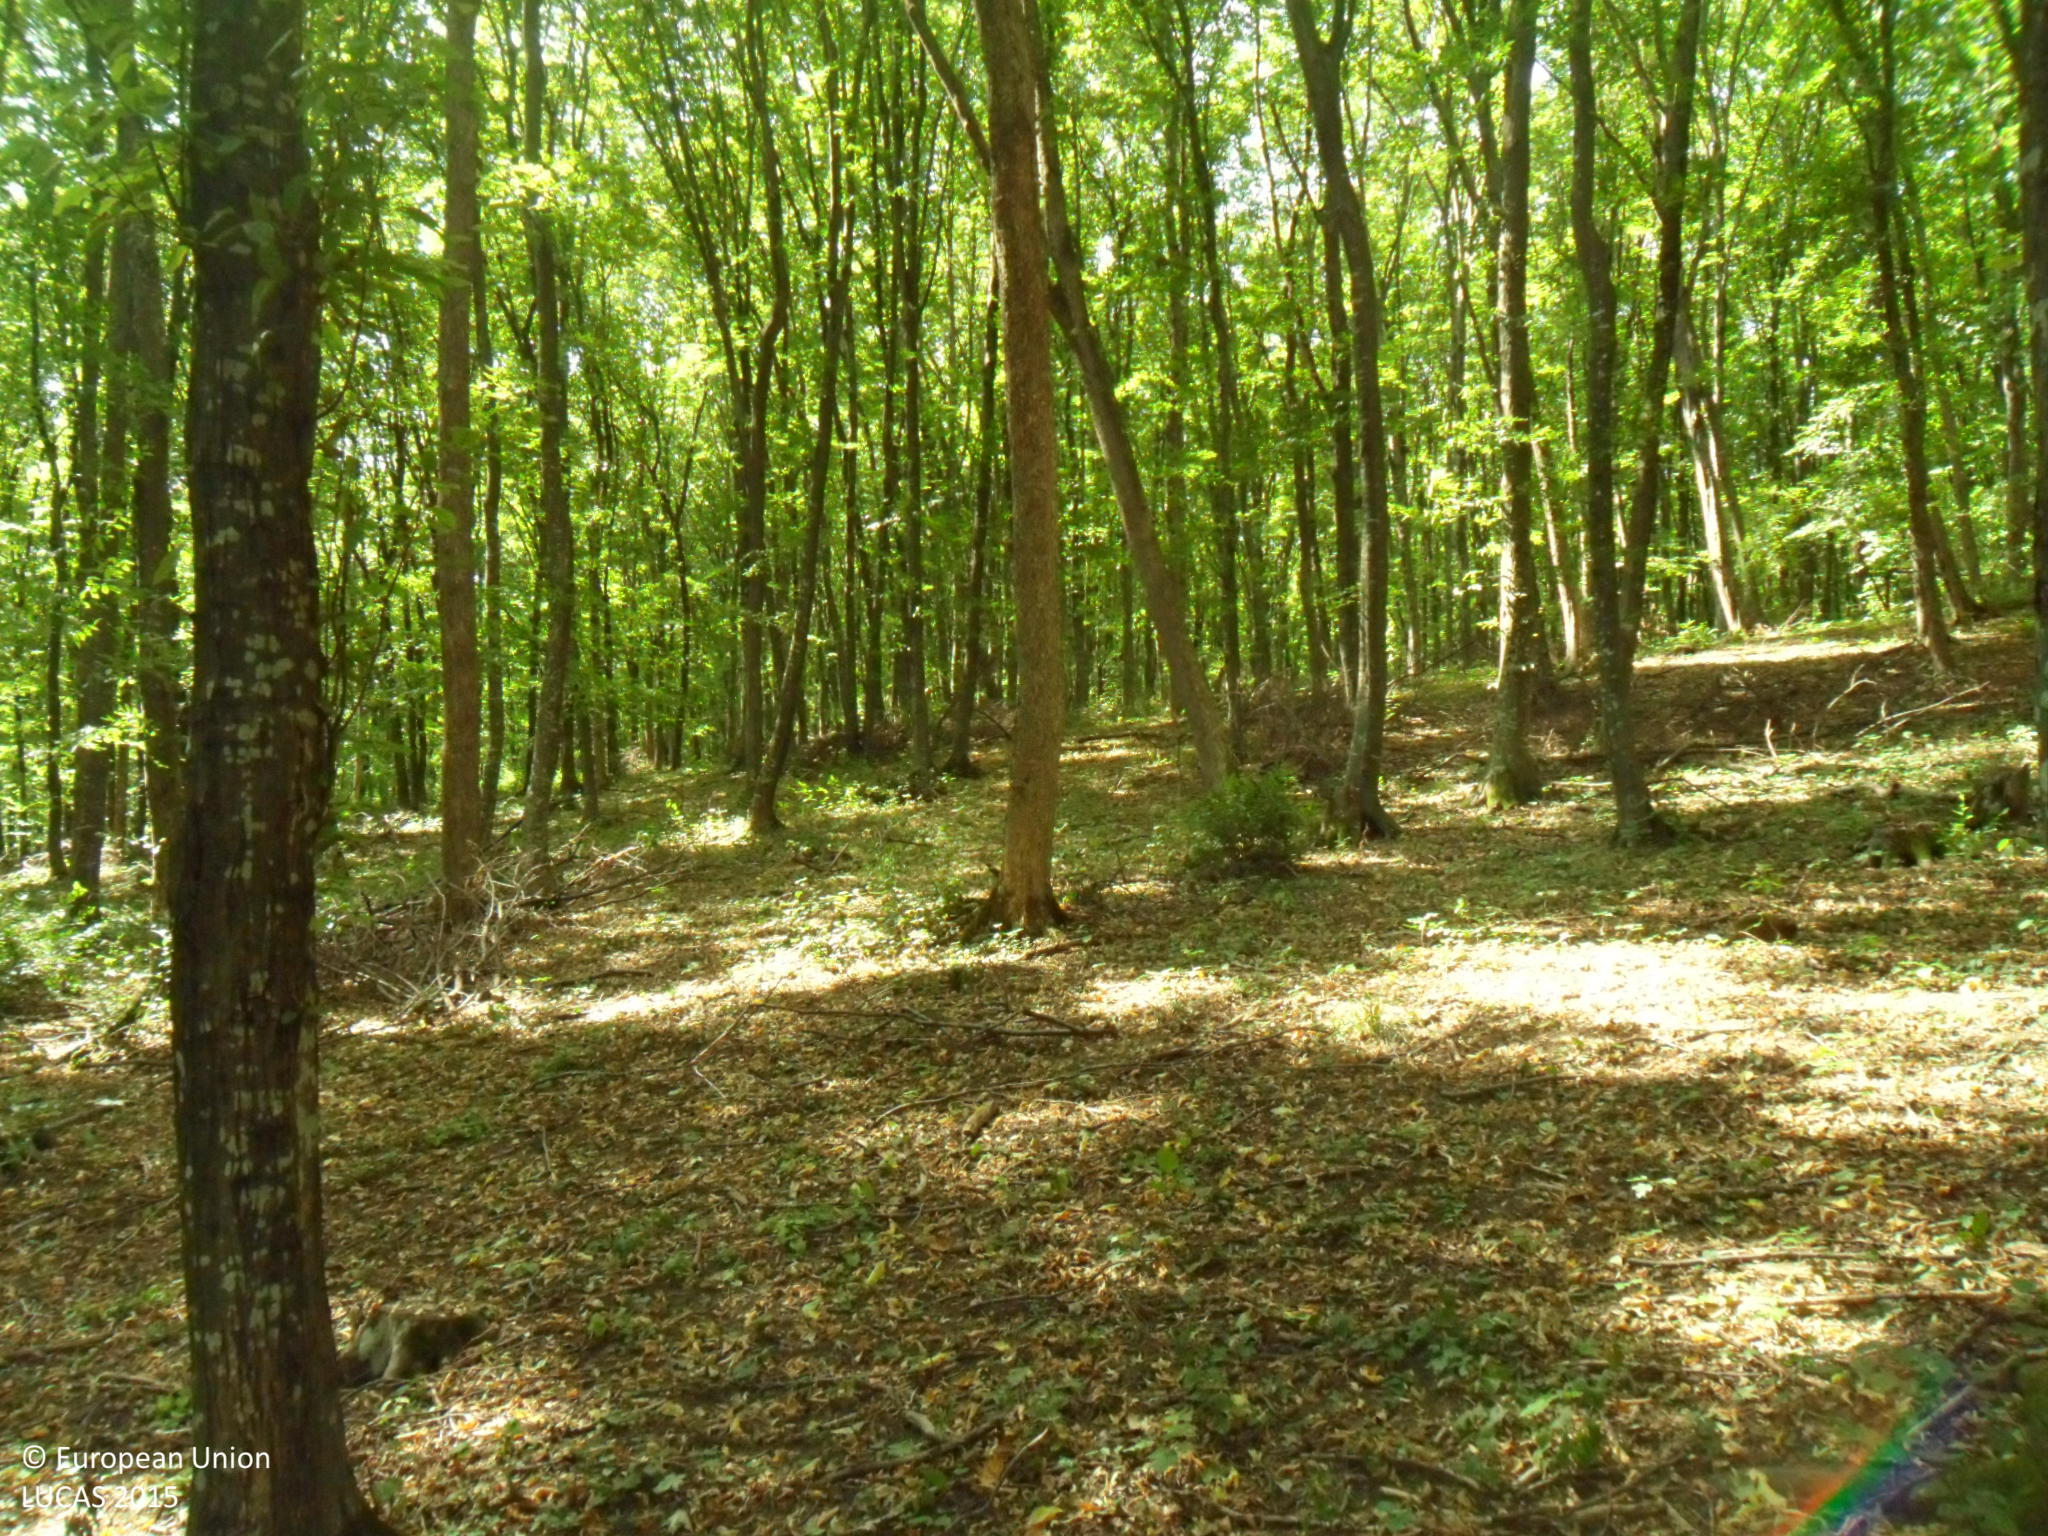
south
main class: Woodland
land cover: Broadleaved woodland
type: beech forest
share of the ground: > 75 %
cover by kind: broadleaved forest trees 100 %
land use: Forestry
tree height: > 5 m
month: September
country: BG
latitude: 43.5684
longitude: 26.2827
